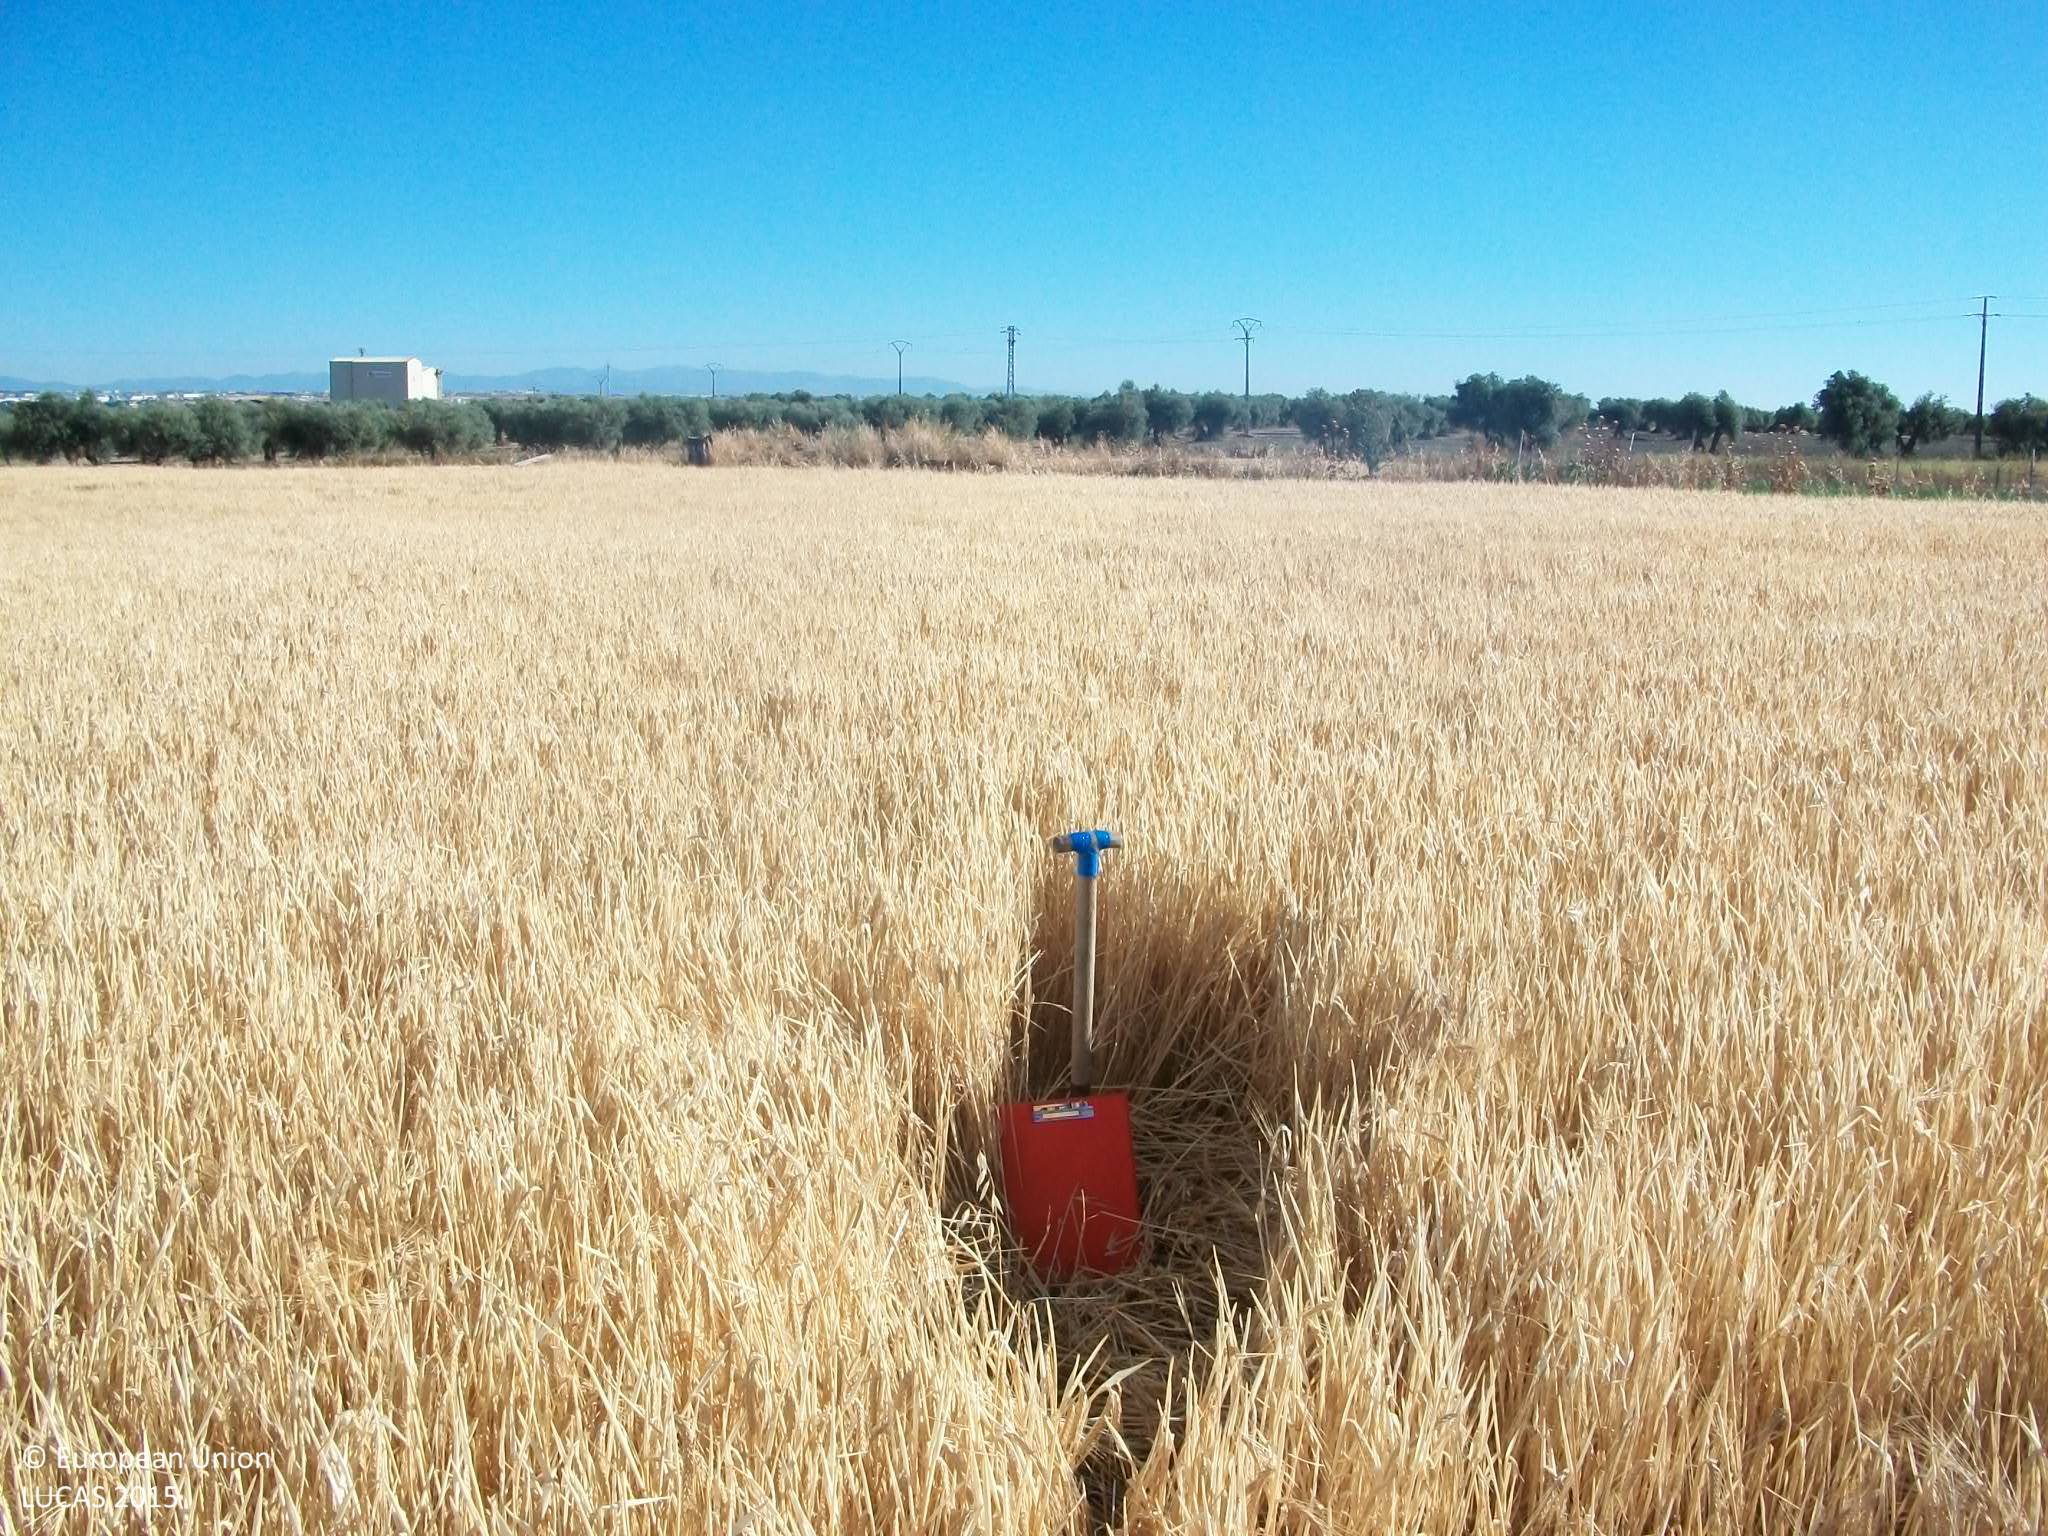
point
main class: Cropland
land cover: Barley
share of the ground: > 75 %
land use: Agriculture (excluding fallow land and kitchen gardens)
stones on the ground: < 10 %
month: June
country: ES
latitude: 40.1153
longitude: -3.7739
